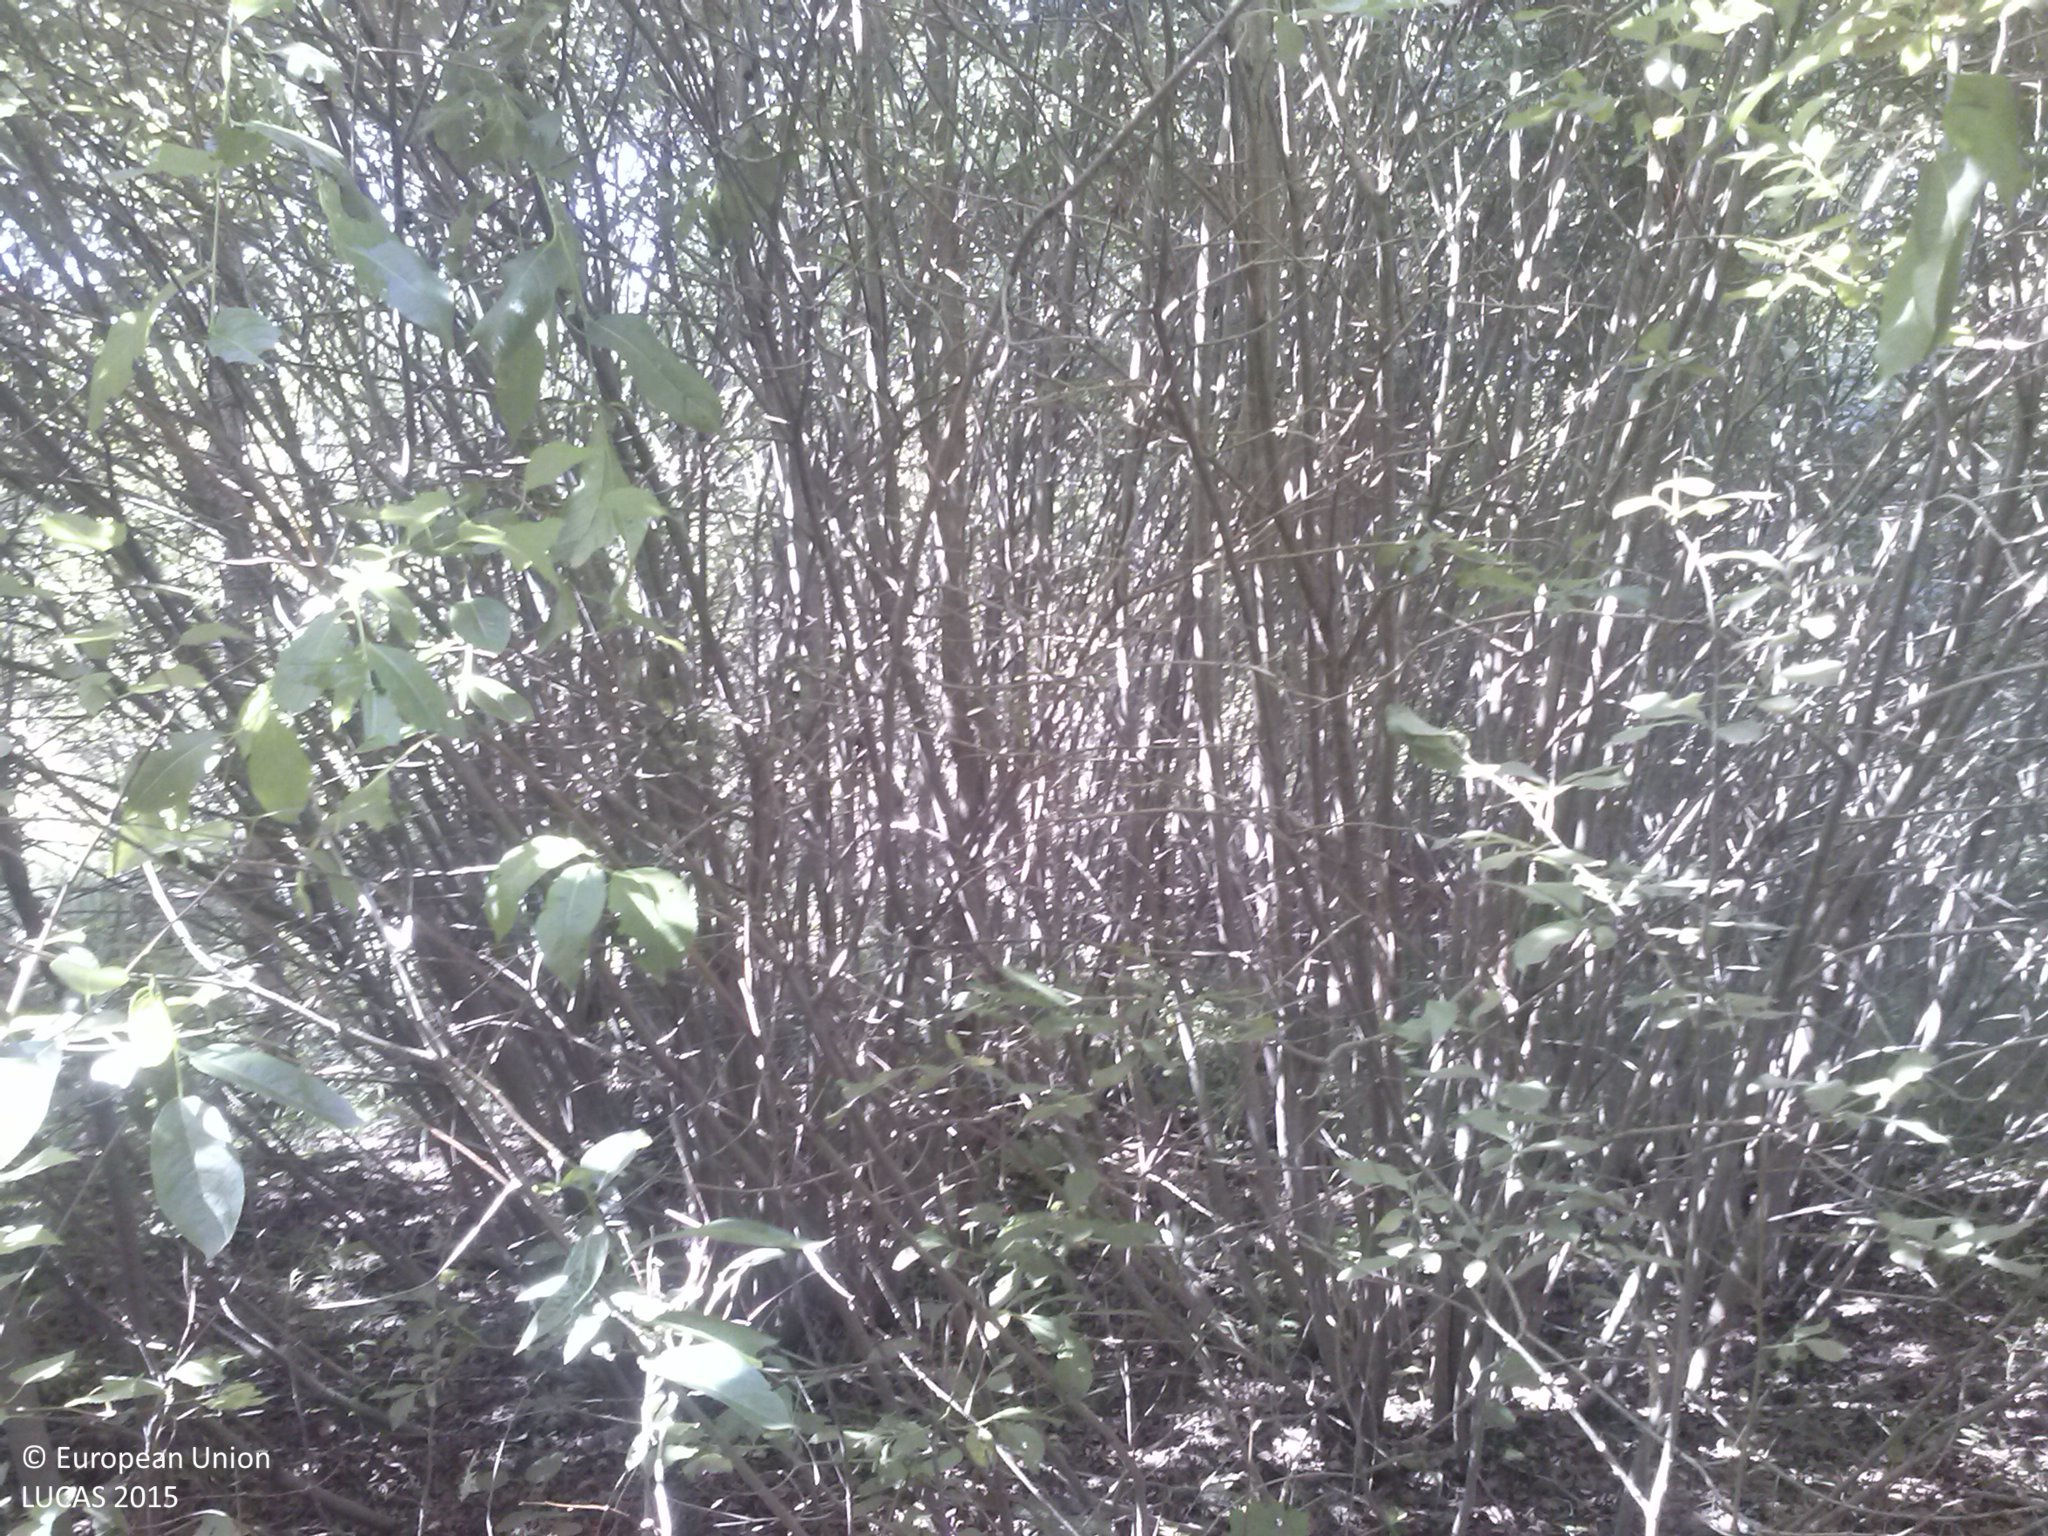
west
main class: Woodland
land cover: Broadleaved woodland
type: non-riverine alder, birch or aspen forest
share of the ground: > 75 %
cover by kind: broadleaved forest trees 85 %, shrubs 10 %, herbaceous plants 5 %
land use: Forestry
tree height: > 5 m
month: August
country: LV
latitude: 56.7218
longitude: 27.6517
